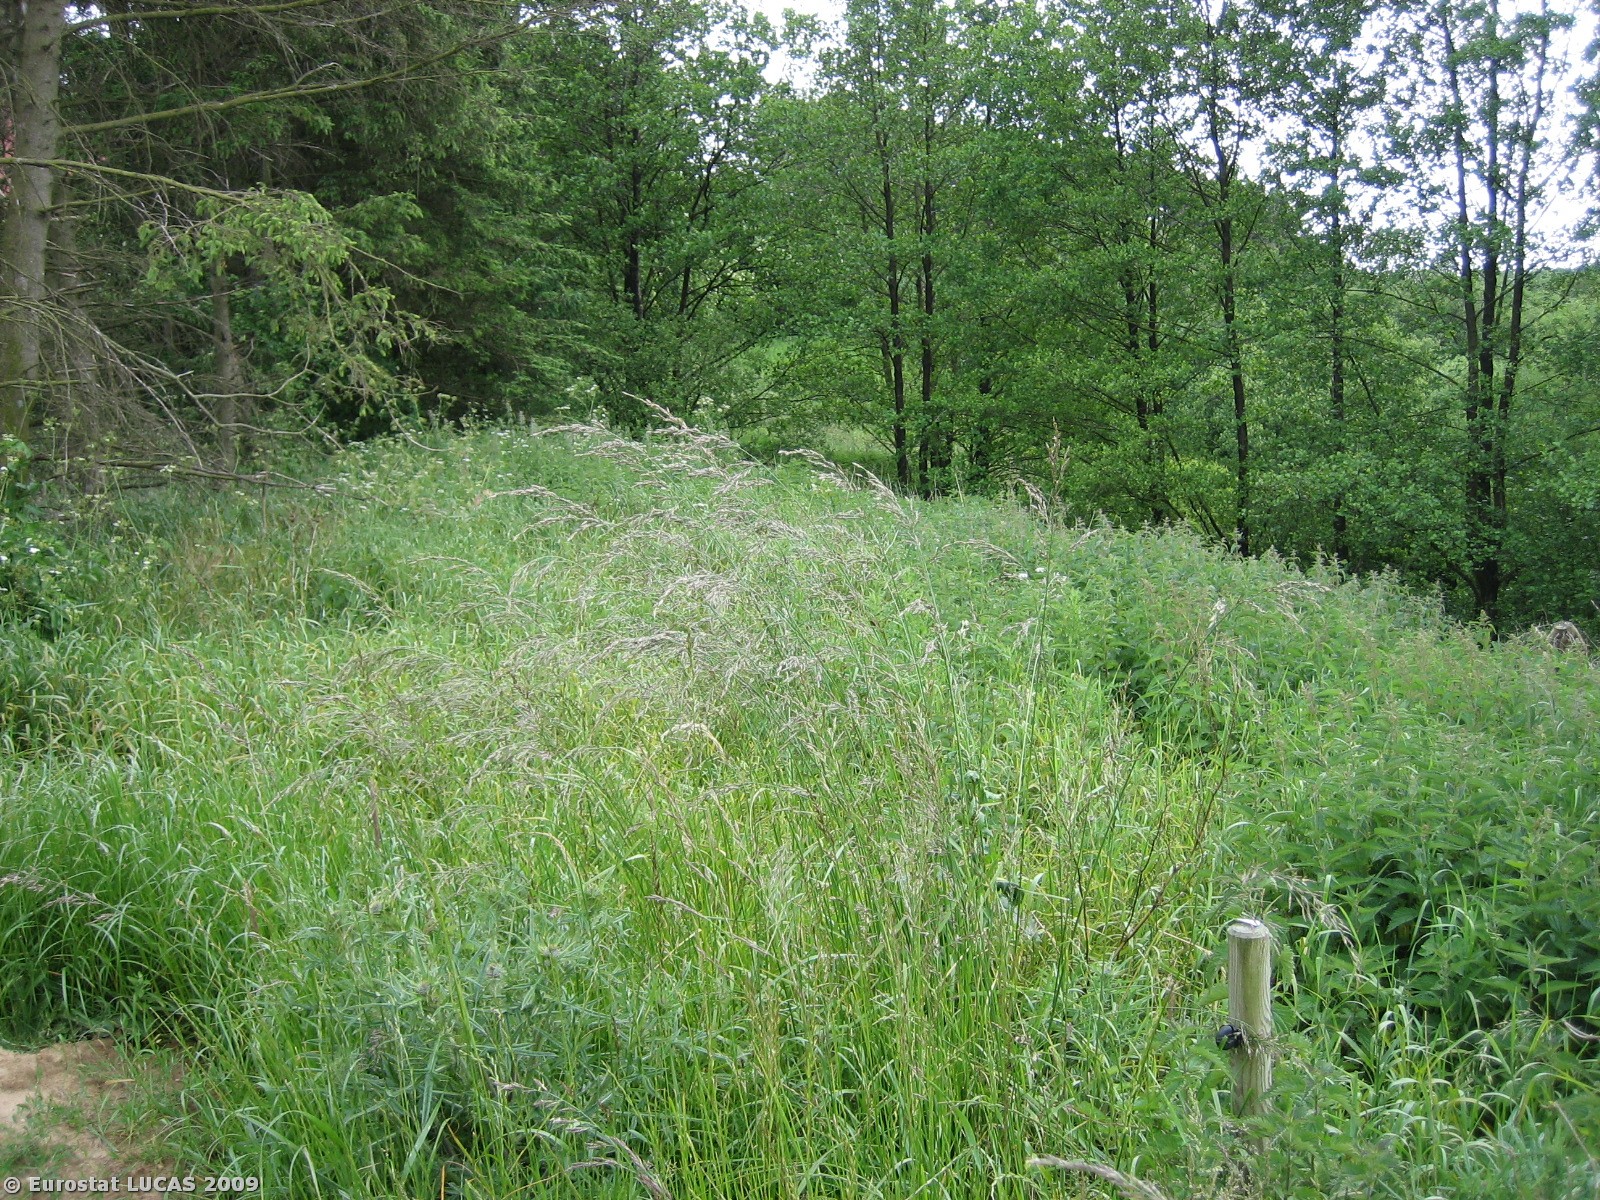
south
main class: Woodland
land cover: Broadleaved woodland
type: mesophytic deciduous forest
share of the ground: > 75 %
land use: Forestry
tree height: > 5 m
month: June
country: DK
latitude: 55.6102
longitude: 9.2229
